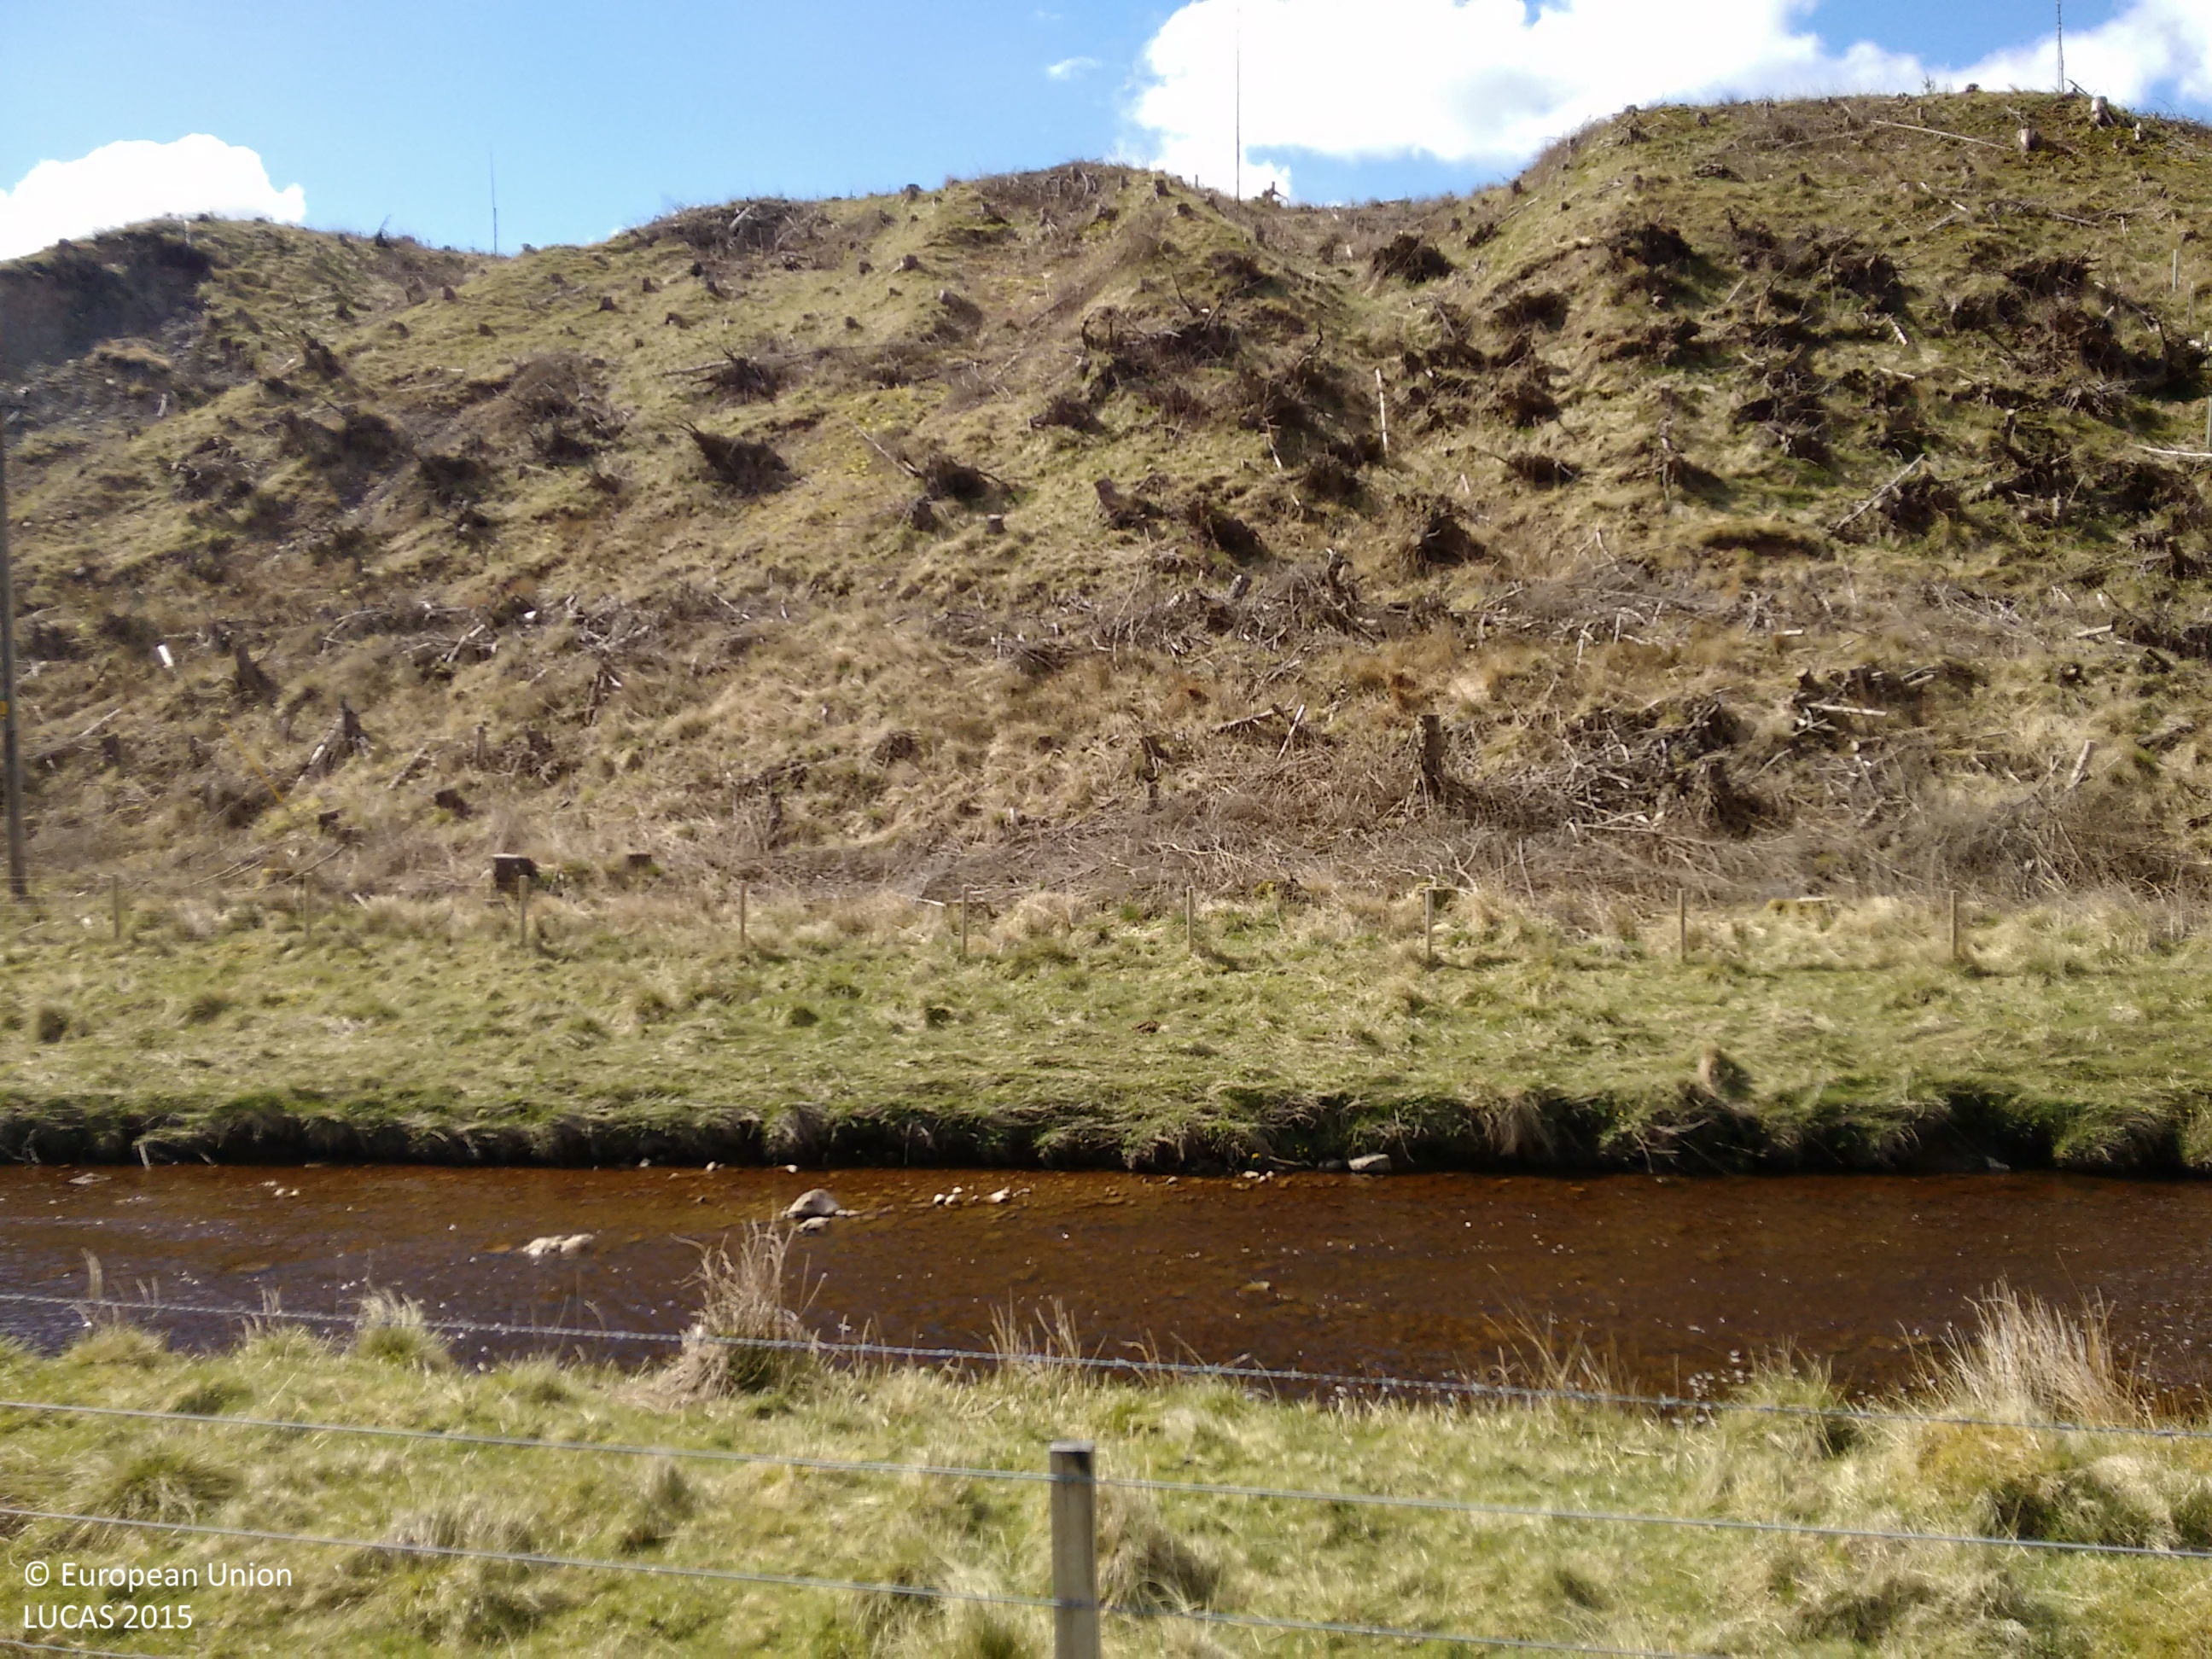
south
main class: Grassland
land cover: Spontaneously vegetated surfaces
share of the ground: 50 - 75 %
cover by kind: herbaceous plants 90 %, shrubs 5 %
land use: Forestry
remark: Clear cut
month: May
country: GB
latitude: 55.4238
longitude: -3.0748
